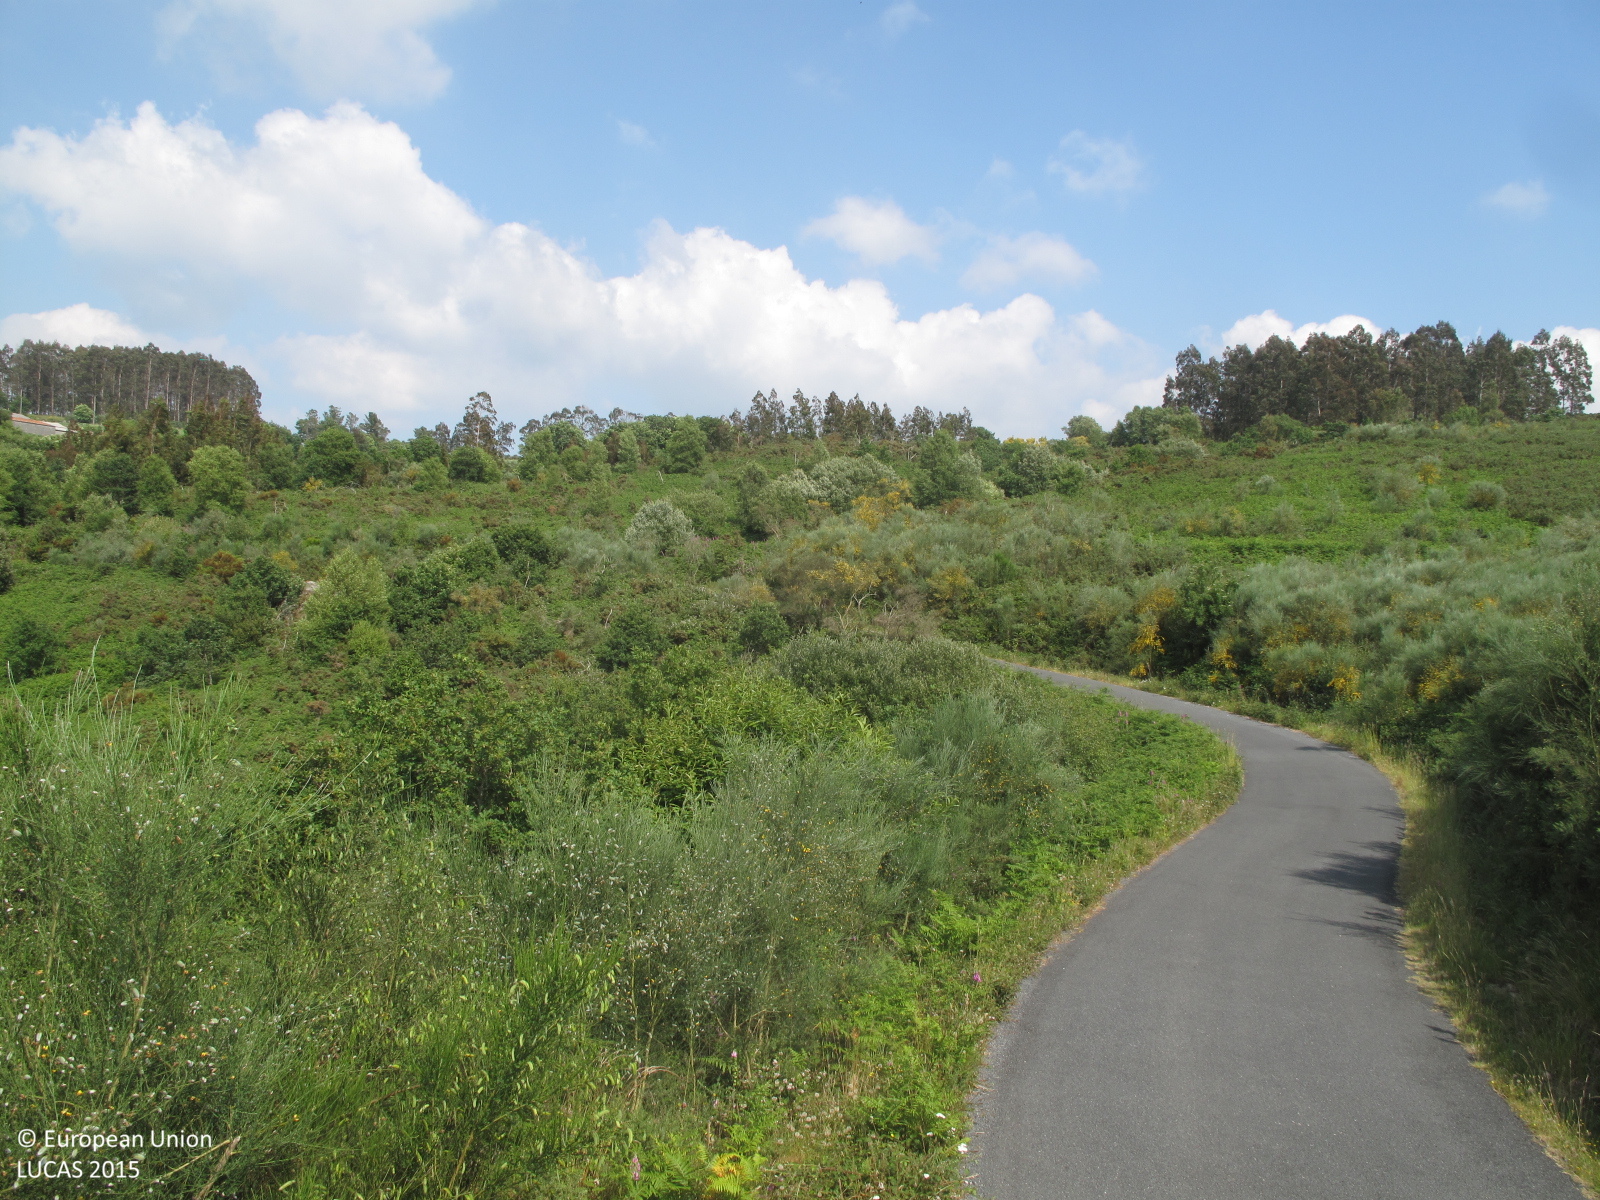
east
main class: Shrubland
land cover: Shrubland without tree cover
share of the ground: > 75 %
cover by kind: shrubs 100 %
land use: Semi-natural and natural areas not in use
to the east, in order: Shrubland without tree cover; Shrubland with sparse tree cover; Shrubland without tree cover; Shrubland with sparse tree cover; Shrubland without tree cover; Broadleaved woodland; Fences; Grassland without tree/shrub cover
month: June
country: ES
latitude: 43.0243
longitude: -7.9689
